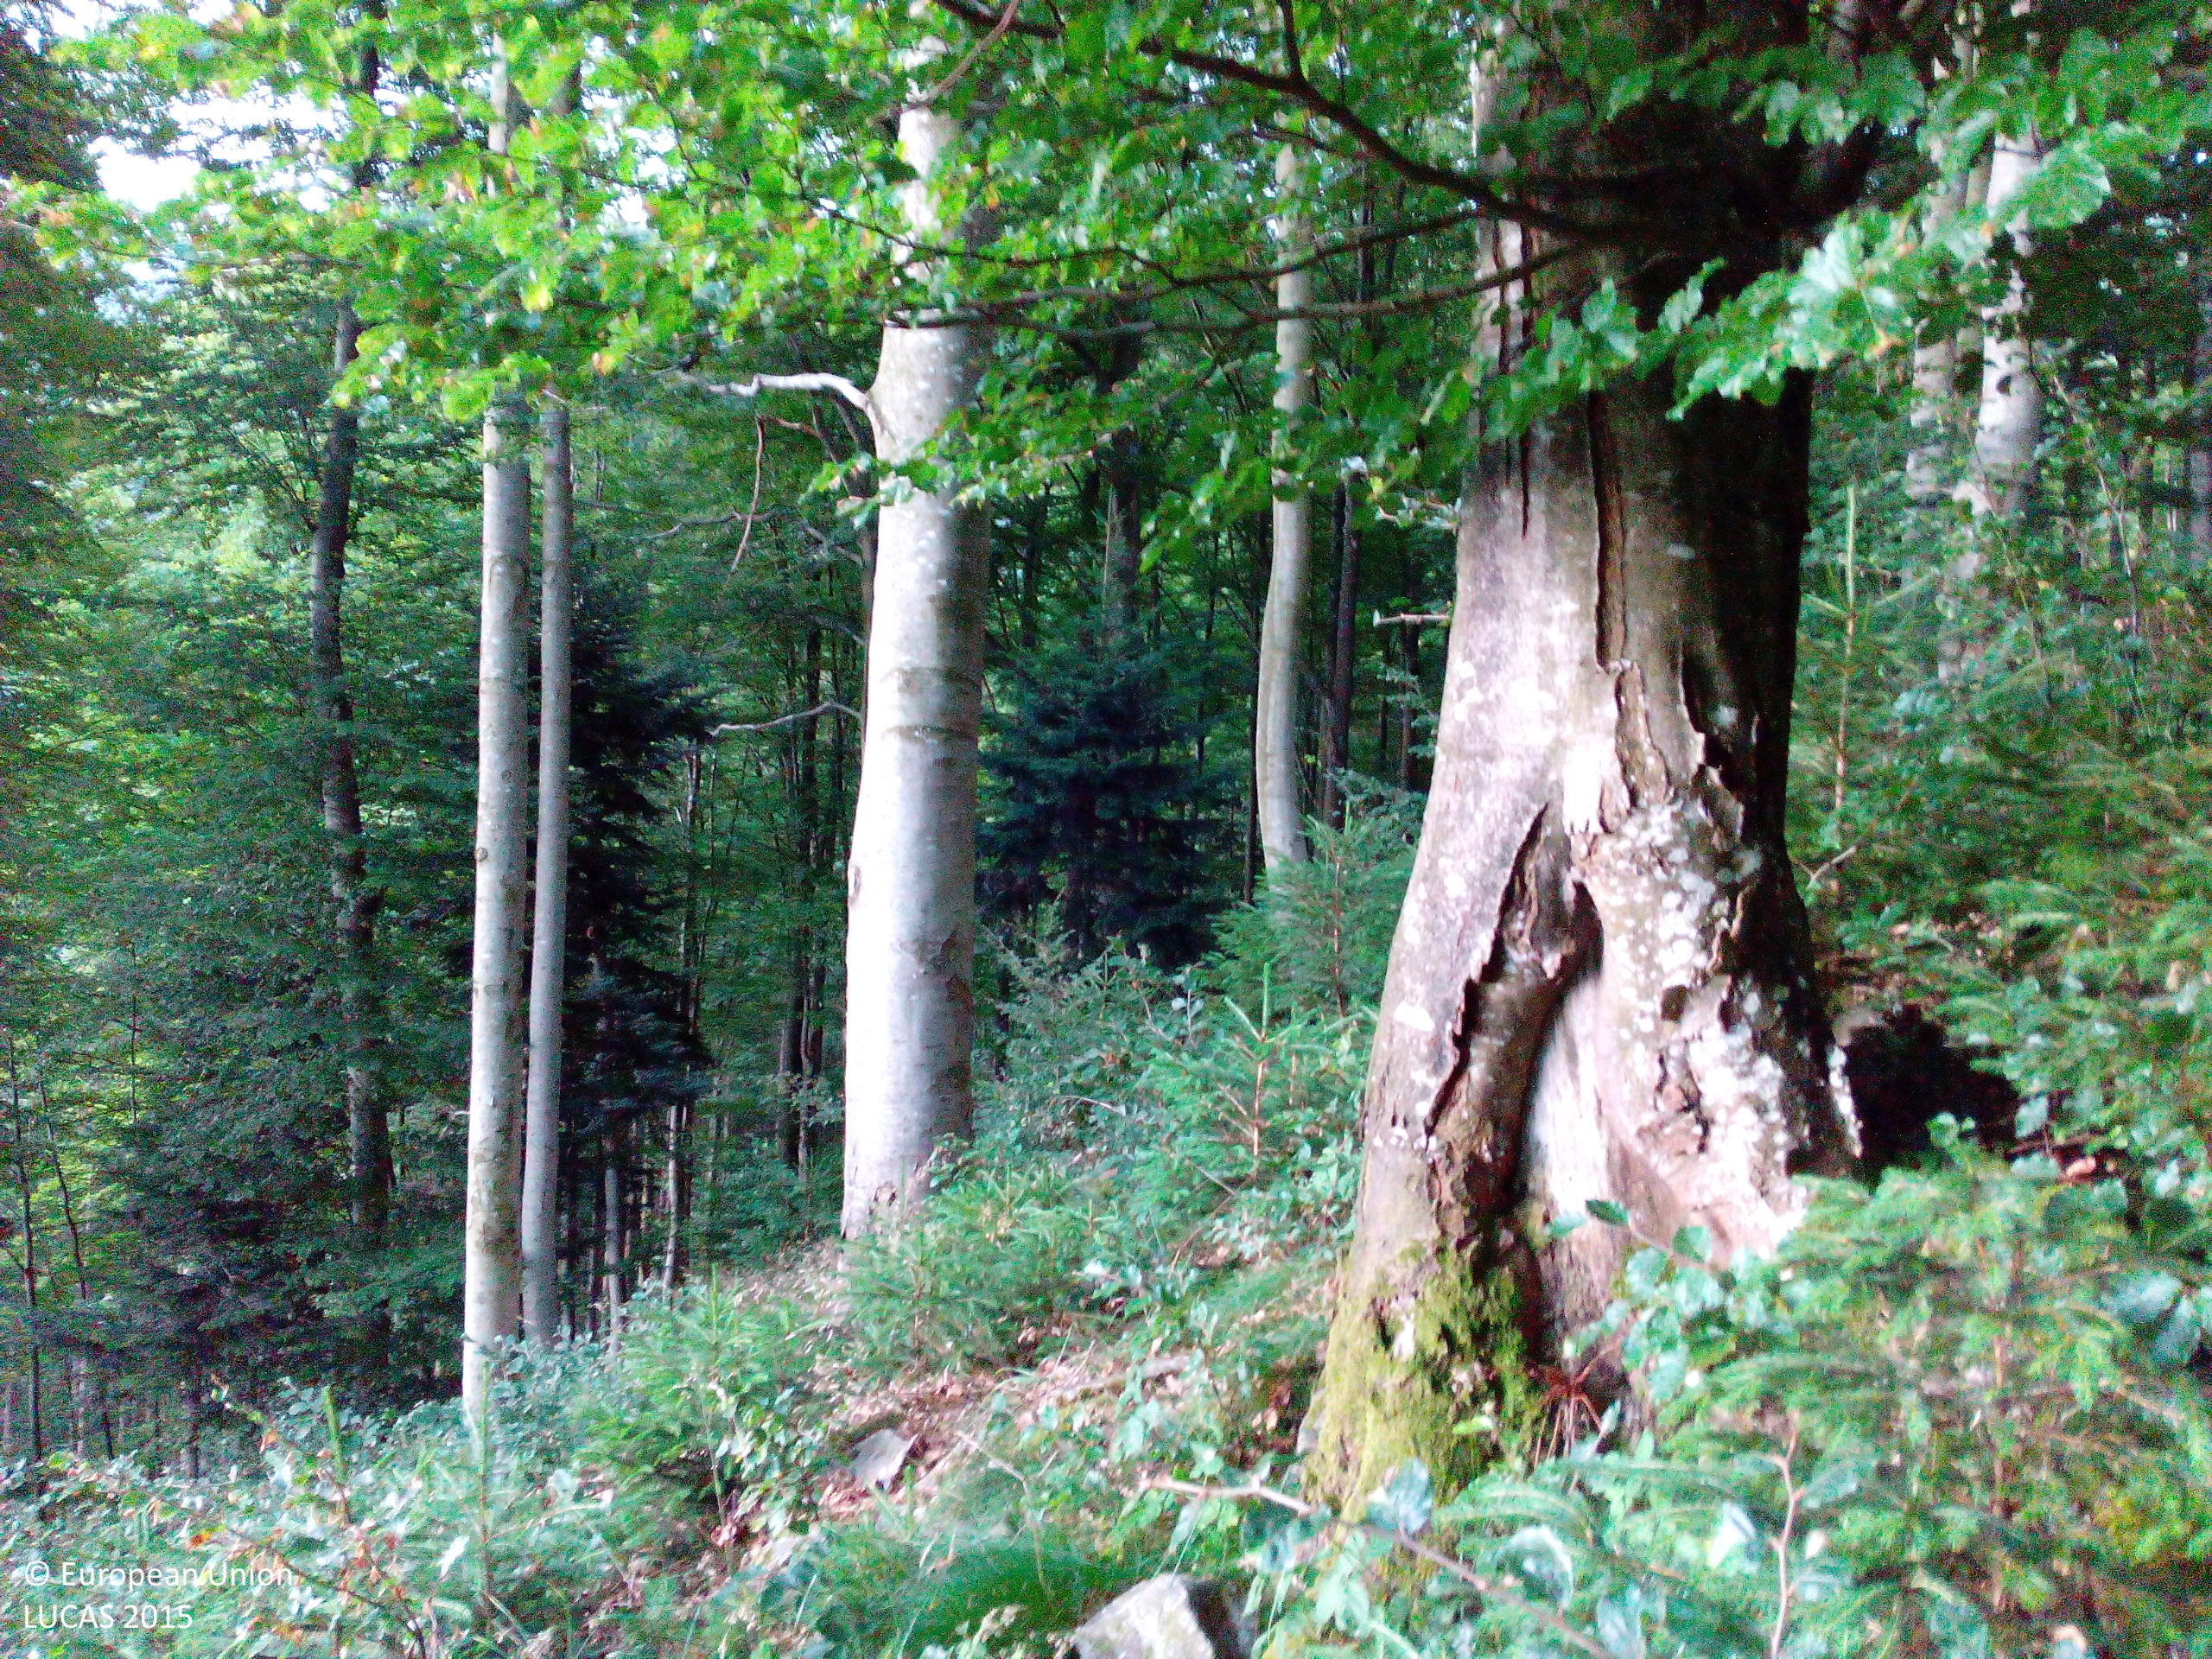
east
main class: Woodland
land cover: Spruce dominated mixed woodland
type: hemiboreal forest and nemoral coniferous forest and mixed broadleaved-coniferous forest
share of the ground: > 75 %
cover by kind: broadleaved forest trees 50 %, coniferous forest trees 35 %, unconsolidated bare surface 10 %, shrubs 5 %
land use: Forestry
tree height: < 5 m
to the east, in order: Spruce dominated mixed woodland; Broadleaved woodland; Spruce dominated coniferous woodland; Spruce dominated mixed woodland; Tracks; Spruce dominated coniferous woodland; Broadleaved woodland
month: July
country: DE
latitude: 48.1353
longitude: 8.1063
